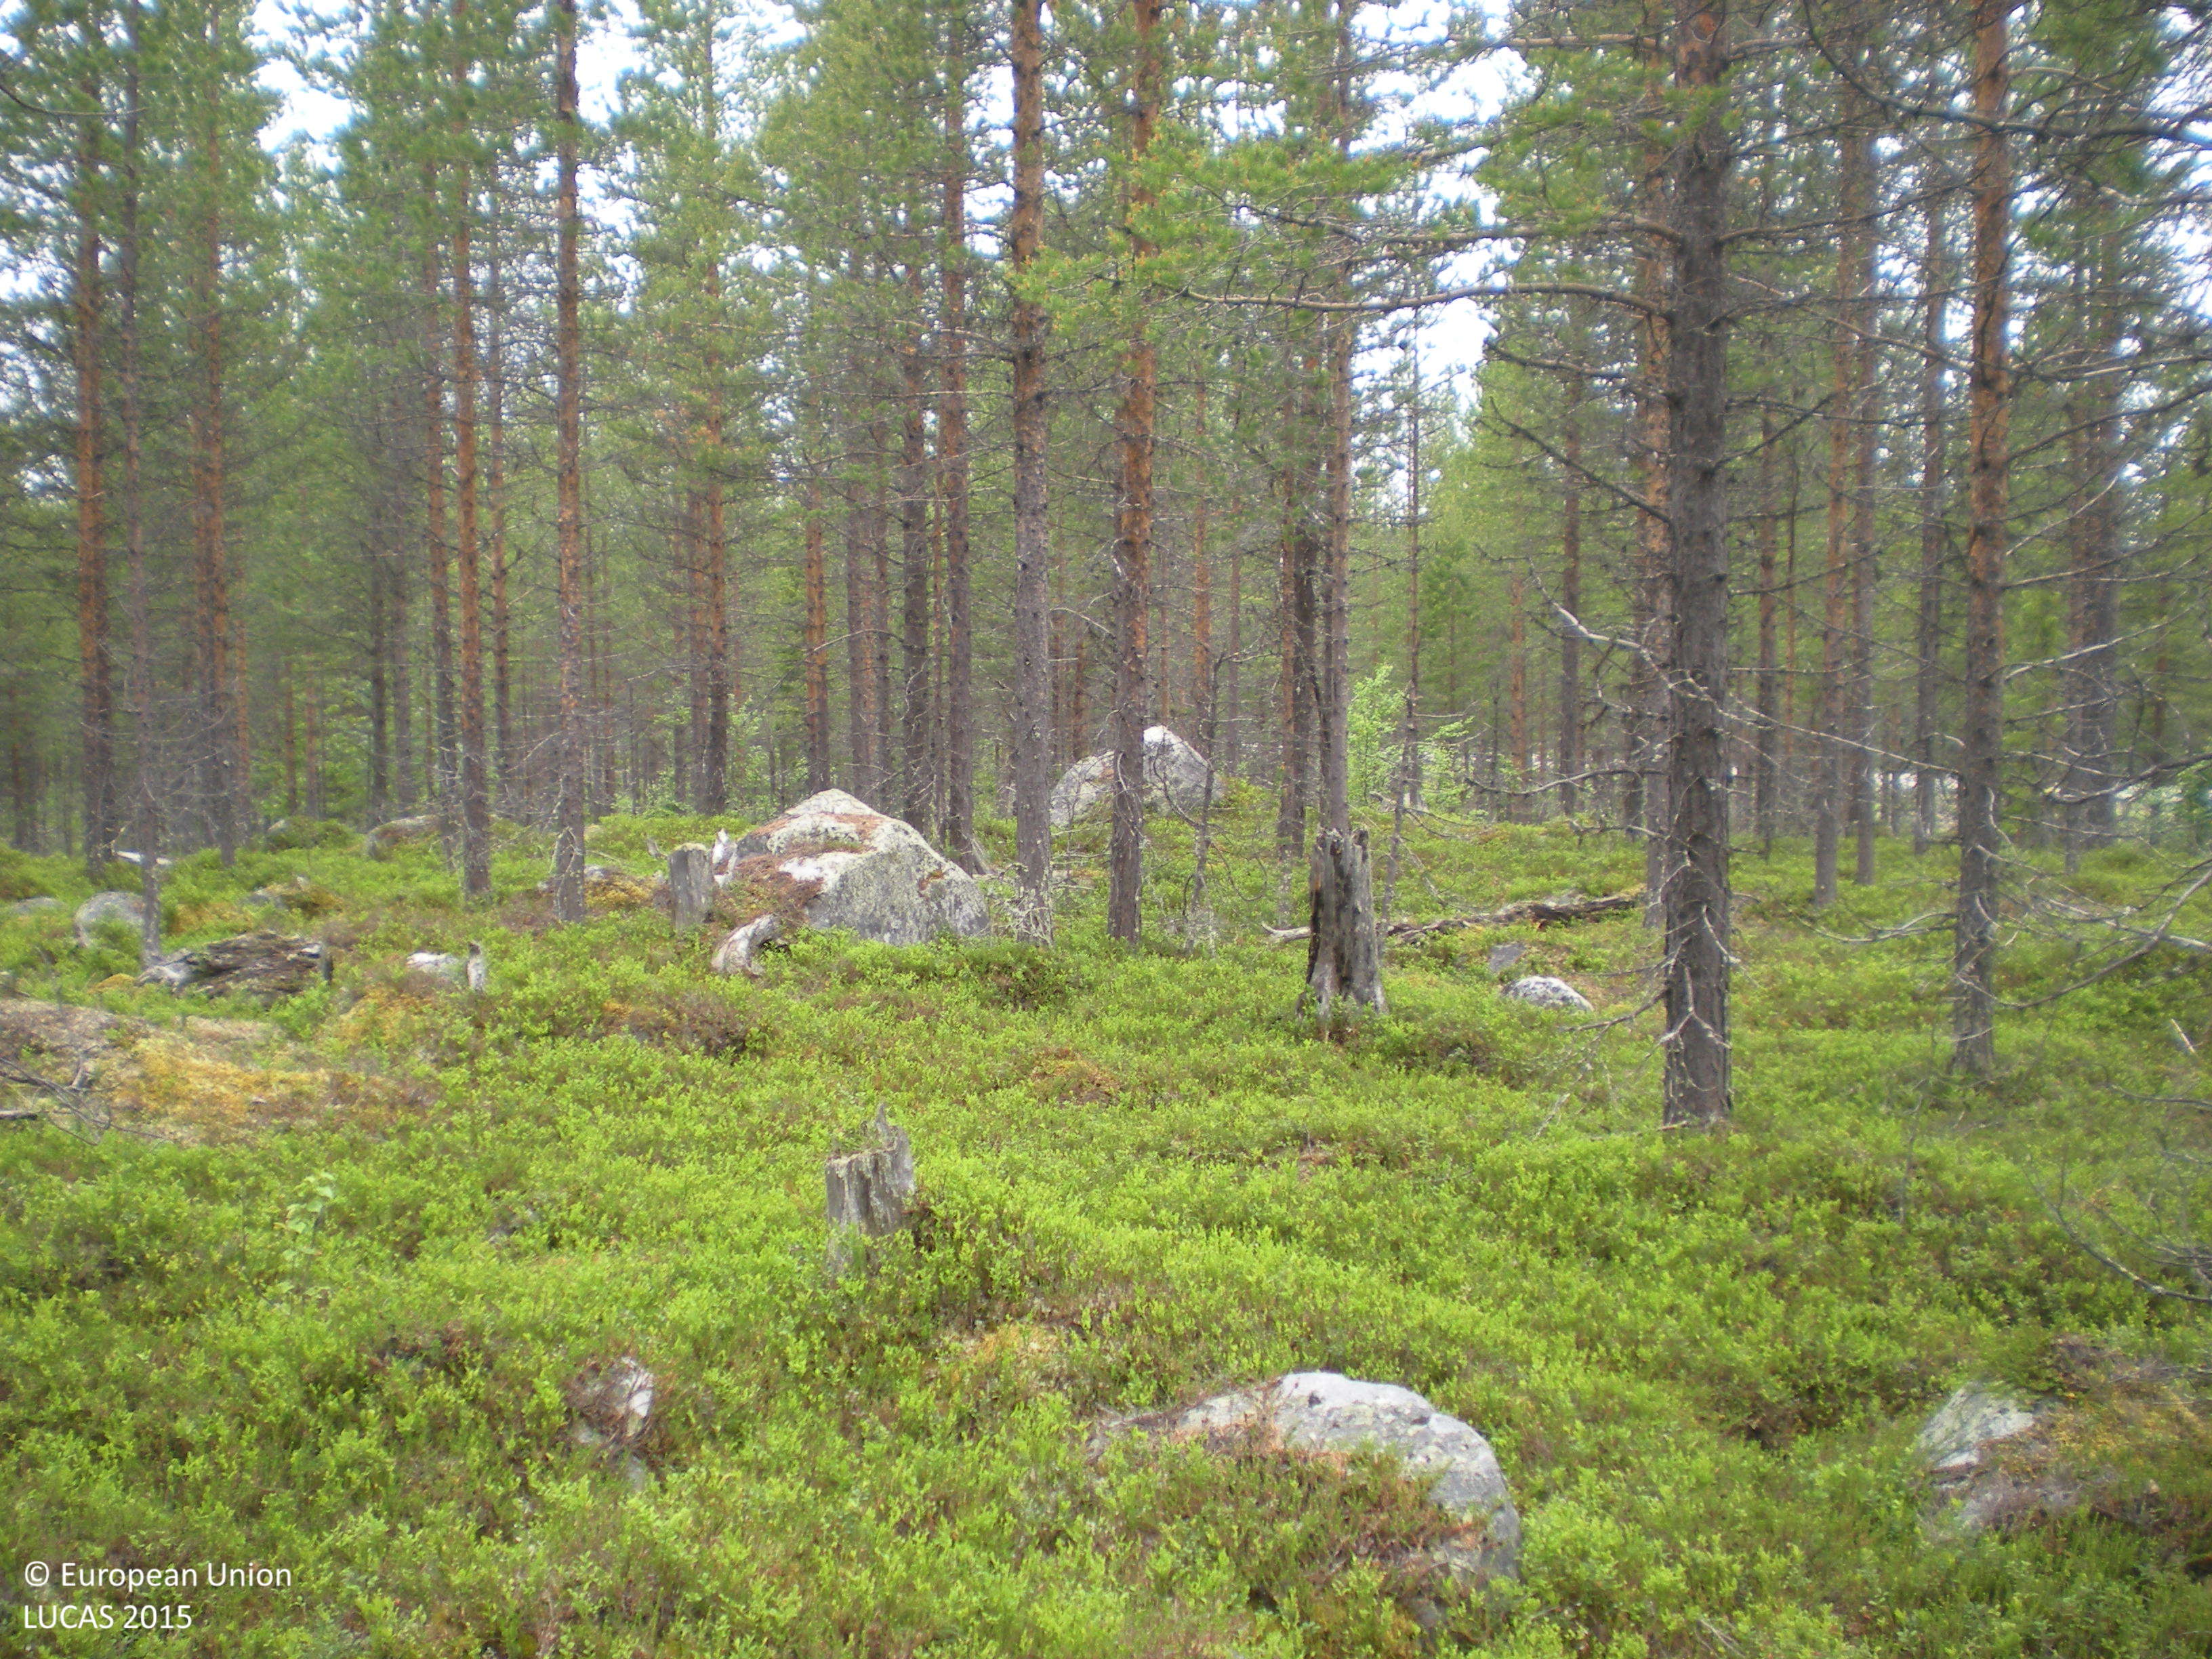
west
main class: Woodland
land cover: Pine dominated coniferous woodland
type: boreal forest
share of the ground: 50 - 75 %
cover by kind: coniferous forest trees 55 %, shrubs 30 %, consolidated bare surface 10 %, lichens and mosses 5 %
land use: Forestry
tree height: > 5 m
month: July
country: SE
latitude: 65.5109
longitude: 17.0733
